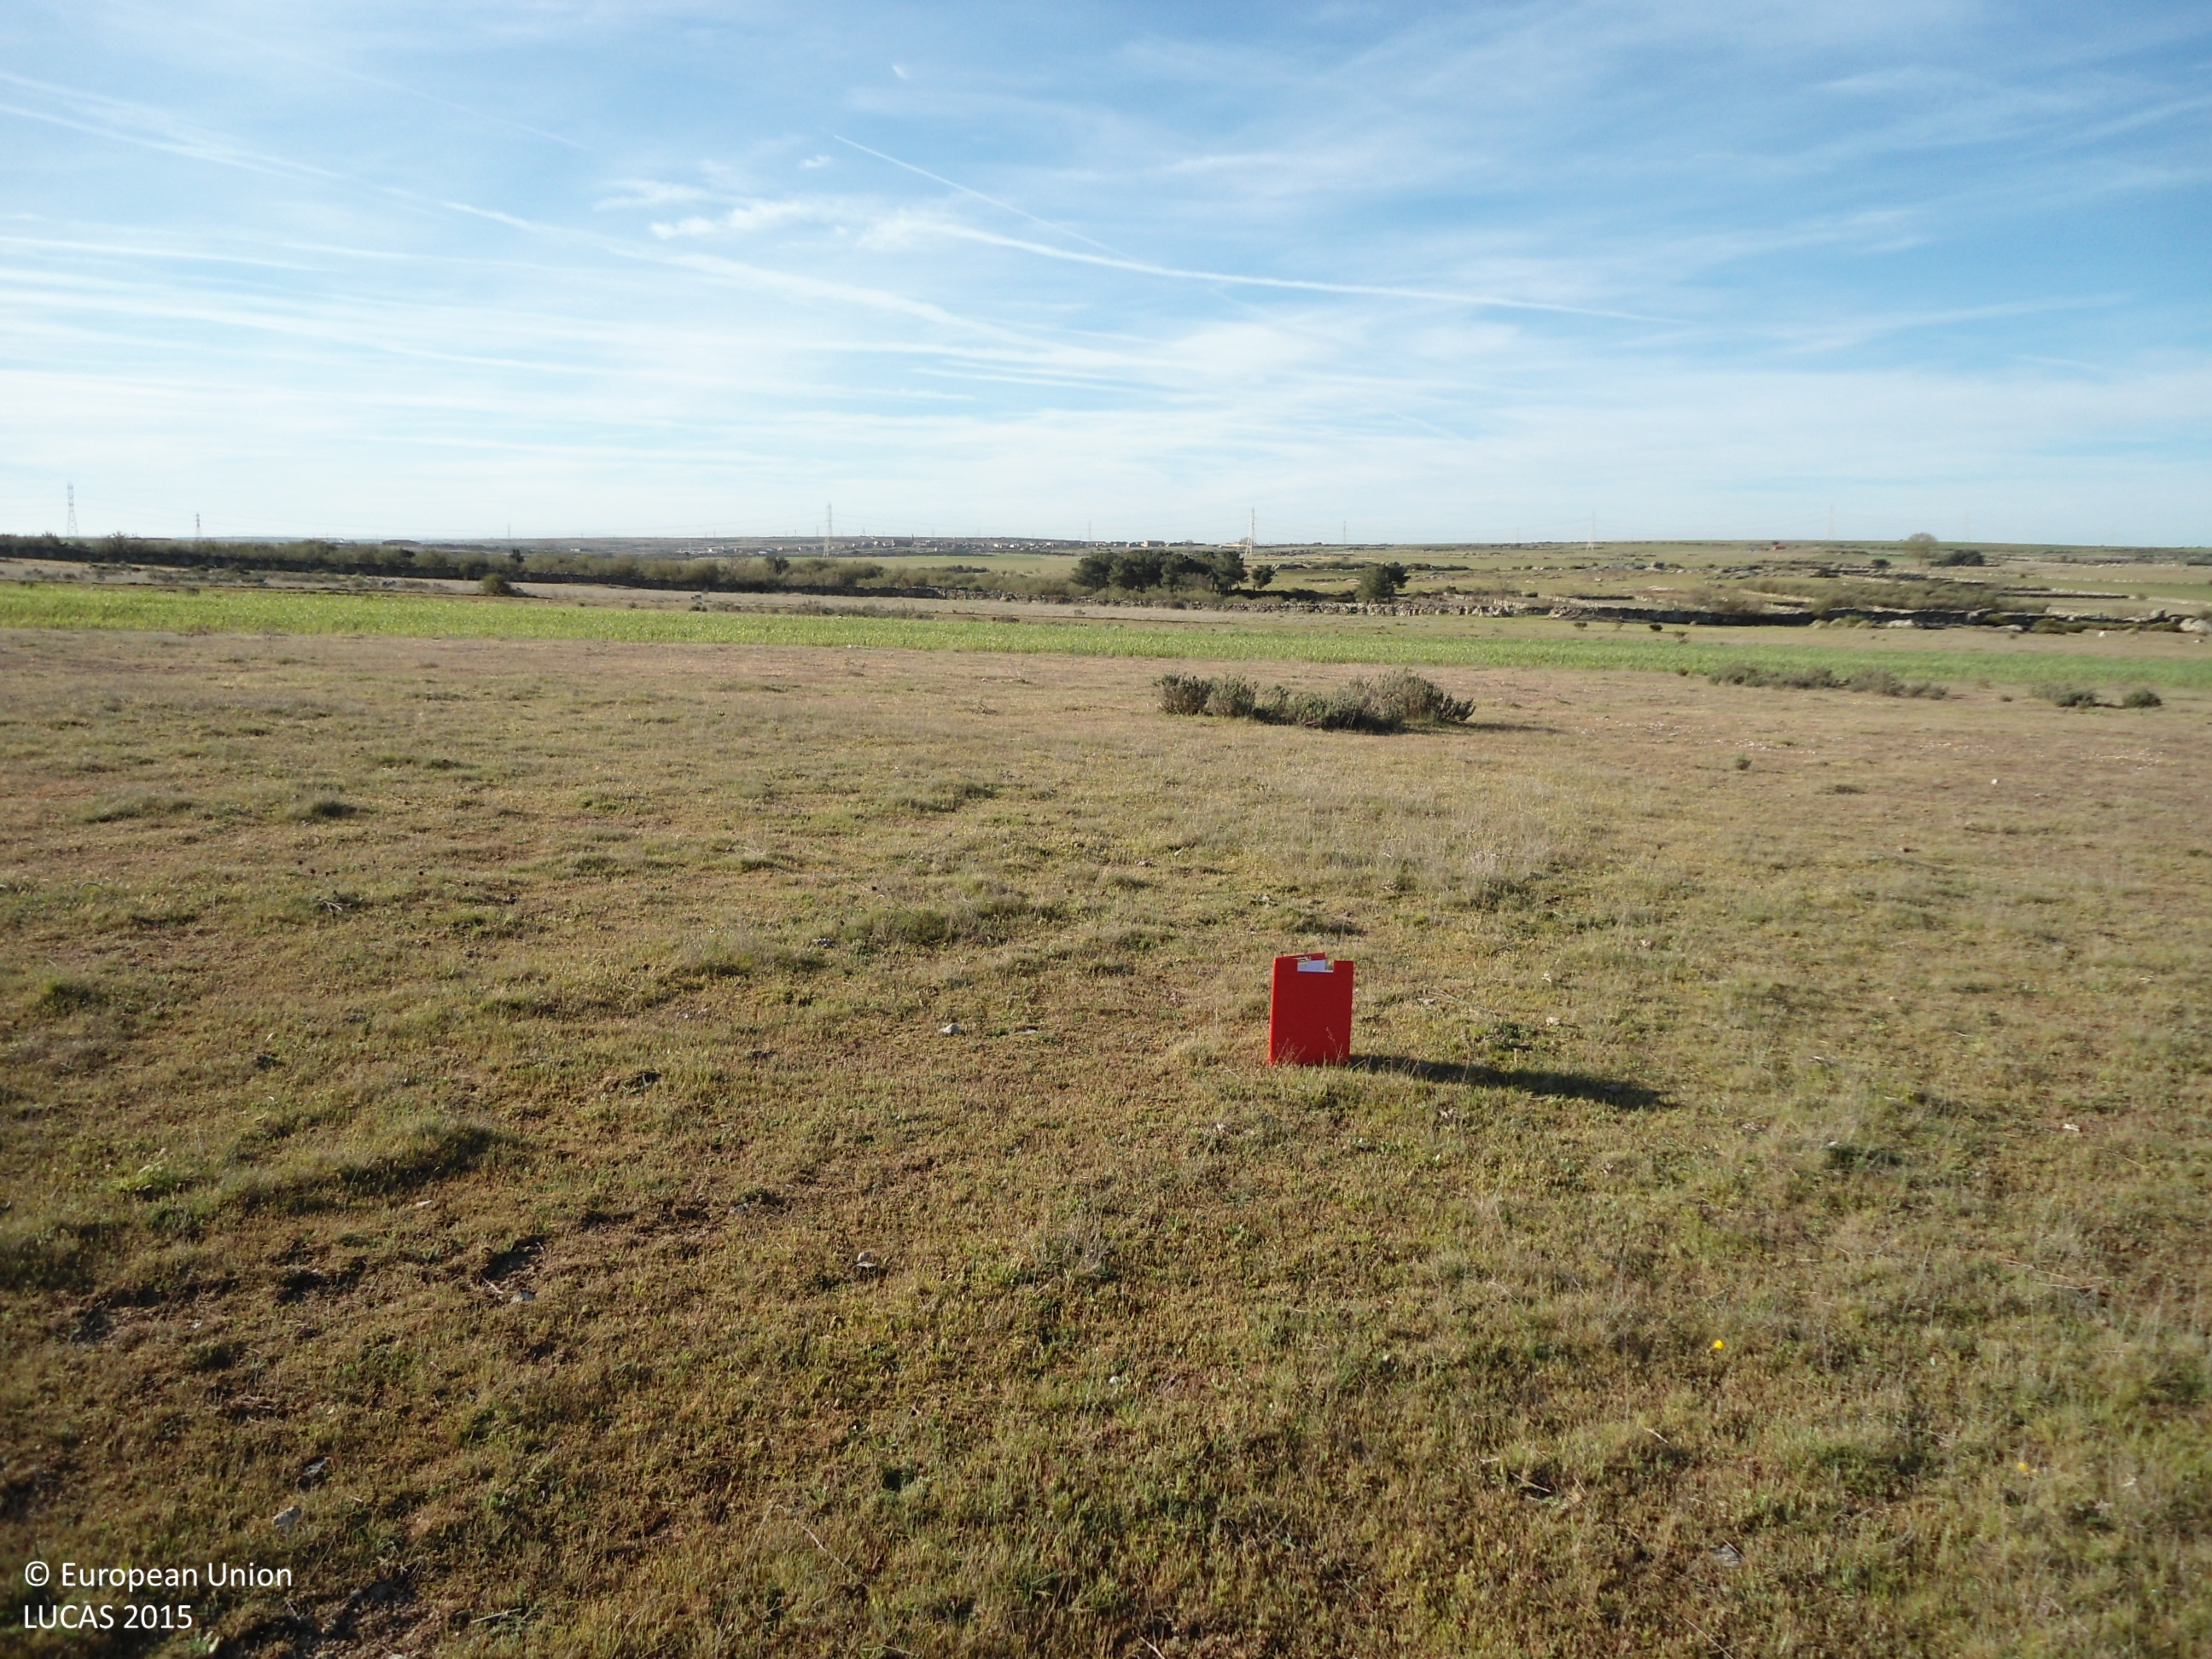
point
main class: Grassland
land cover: Grassland without tree/shrub cover
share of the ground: > 75 %
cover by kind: herbaceous plants 100 %
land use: Agriculture (excluding fallow land and kitchen gardens)
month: April
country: ES
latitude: 41.5481
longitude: -6.0499
